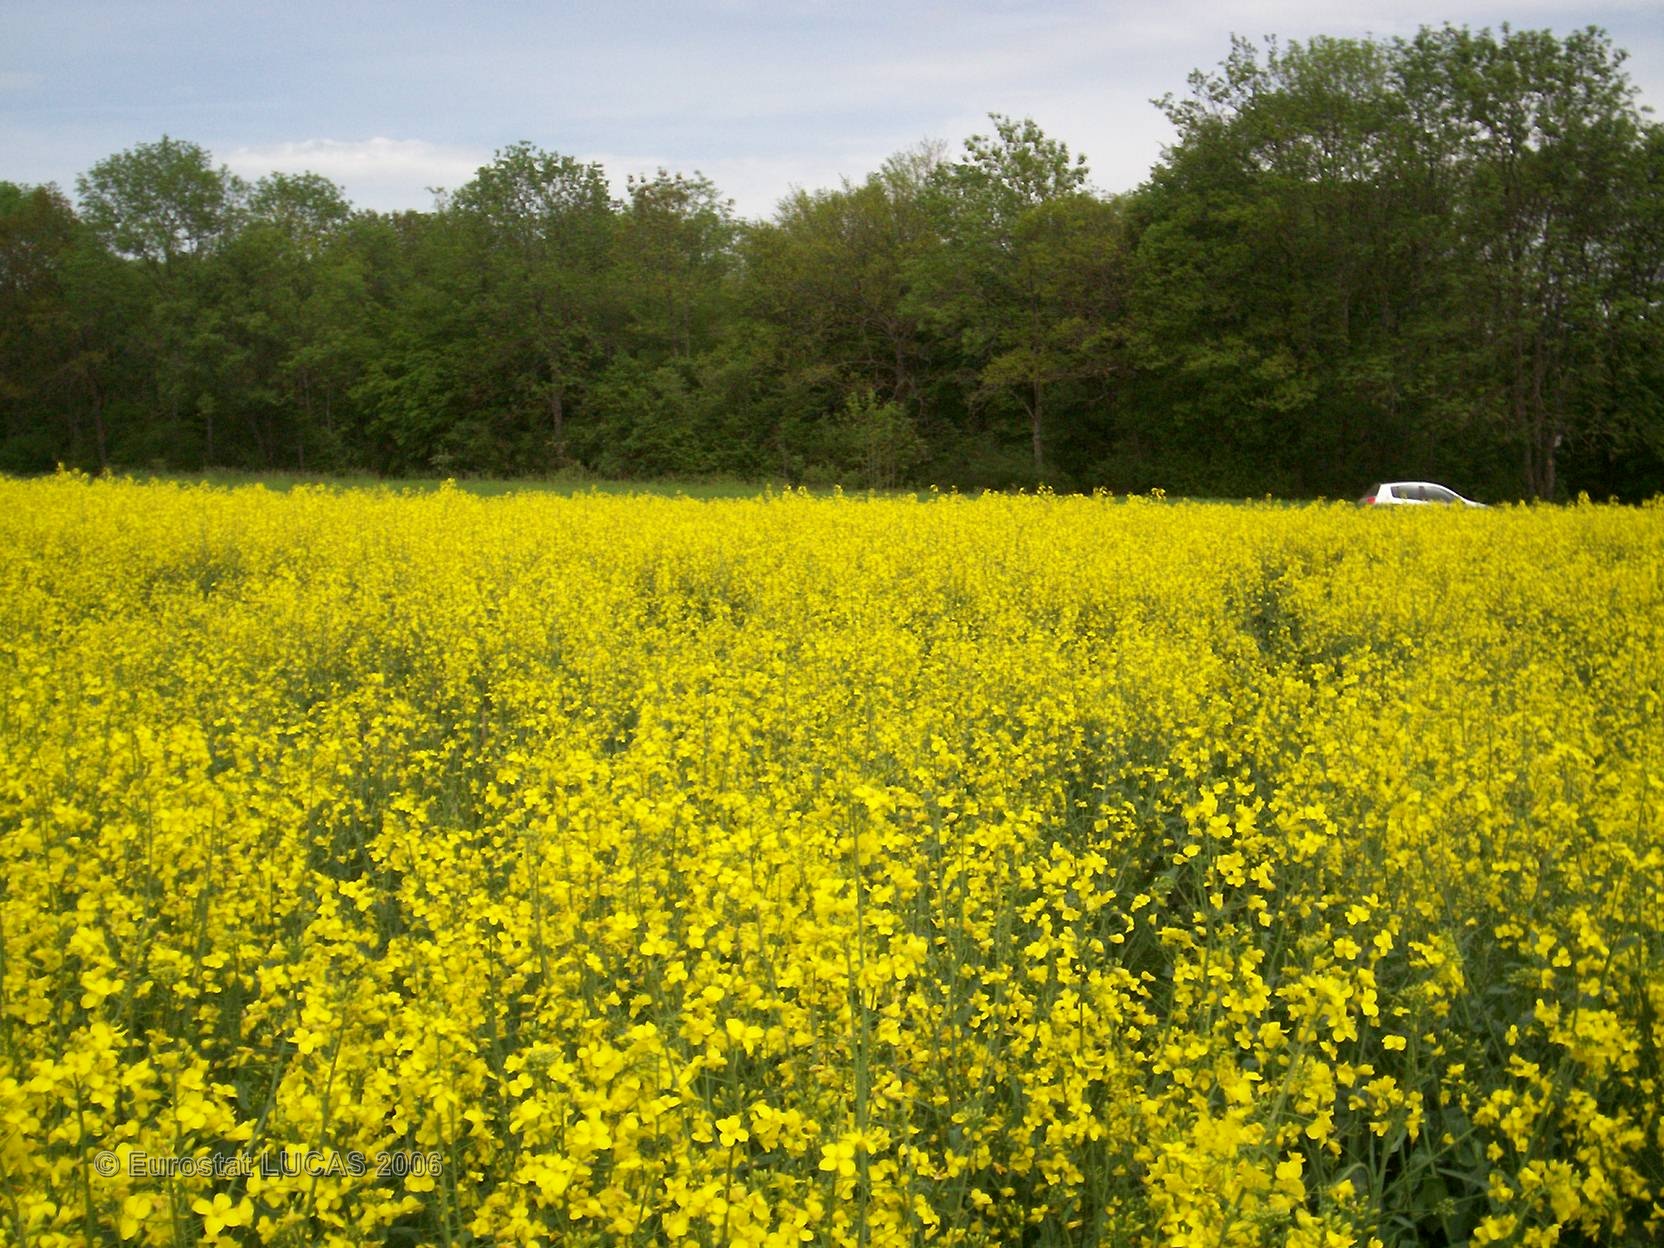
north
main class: Cropland
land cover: Rape and turnip rape
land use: Agriculture (excluding fallow land and kitchen gardens)
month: May
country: FR
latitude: 47.2971
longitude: 4.5909
